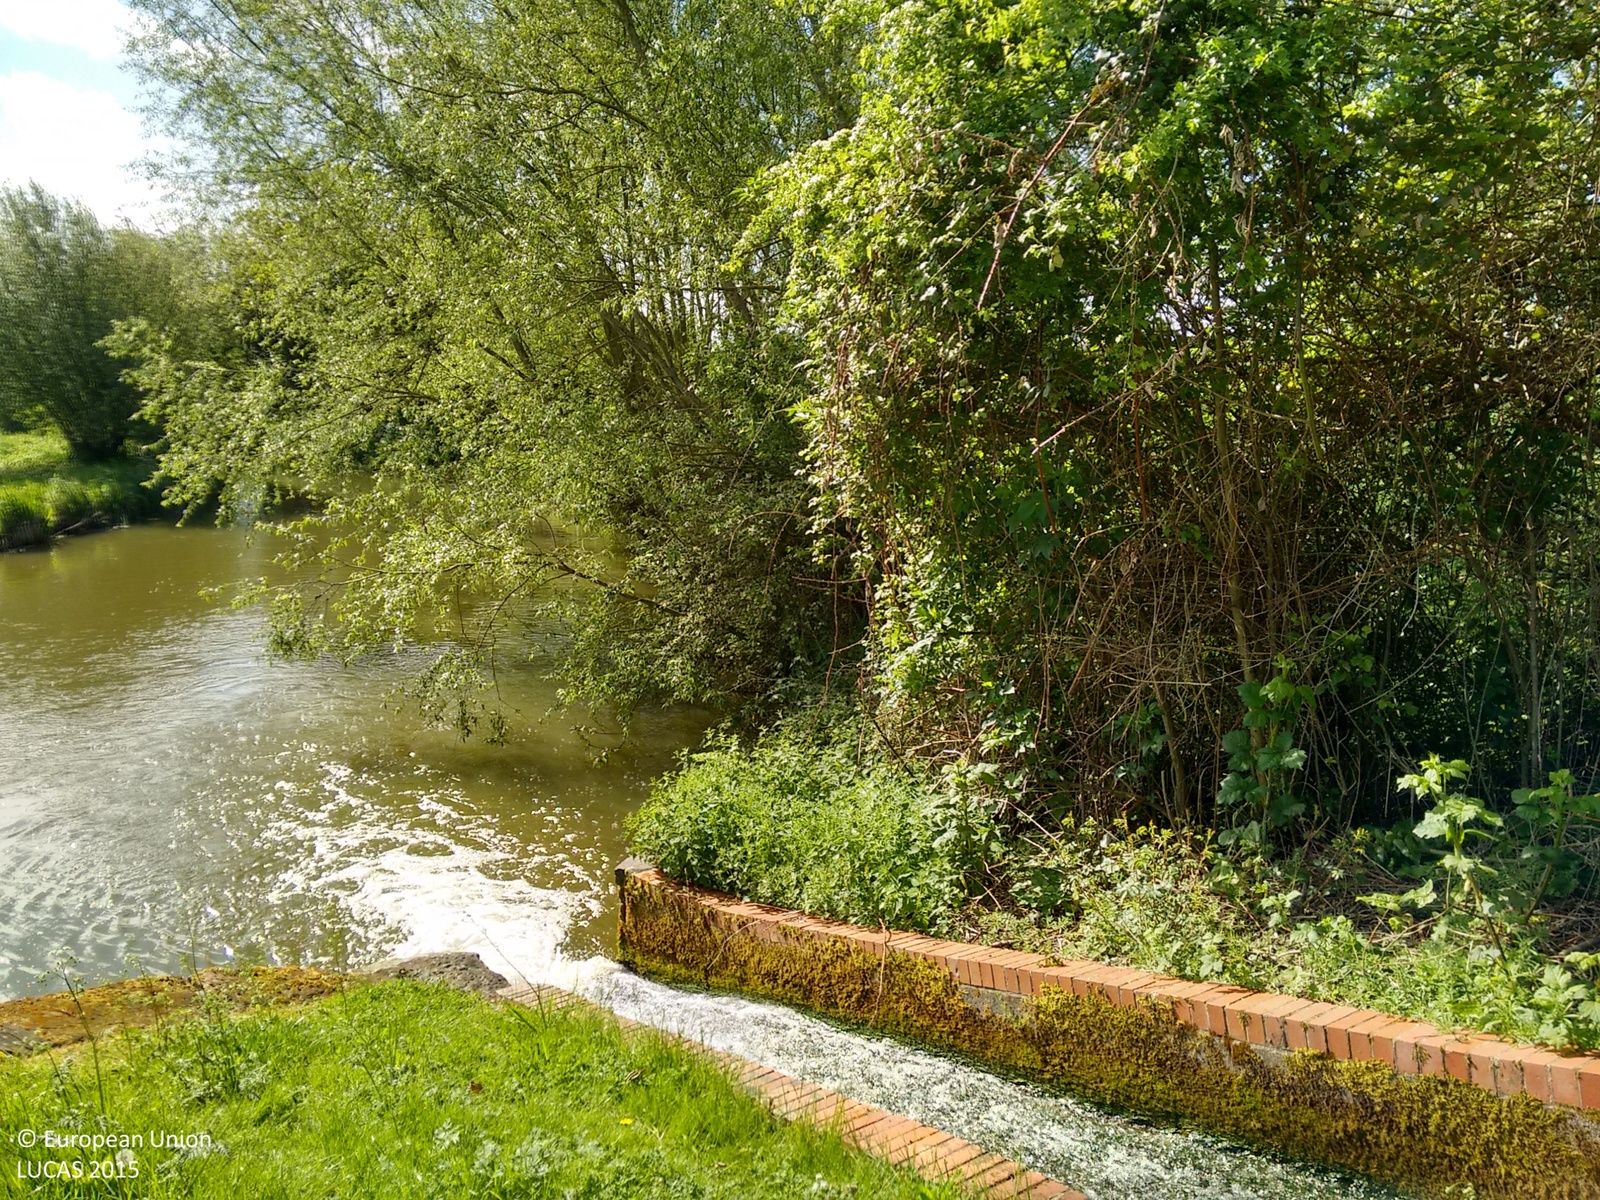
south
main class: Woodland
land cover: Broadleaved woodland
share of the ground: > 75 %
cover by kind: broadleaved forest trees 80 %, shrubs 10 %, herbaceous plants 10 %
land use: Semi-natural and natural areas not in use
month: May
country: GB
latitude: 52.2098
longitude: -1.7475
